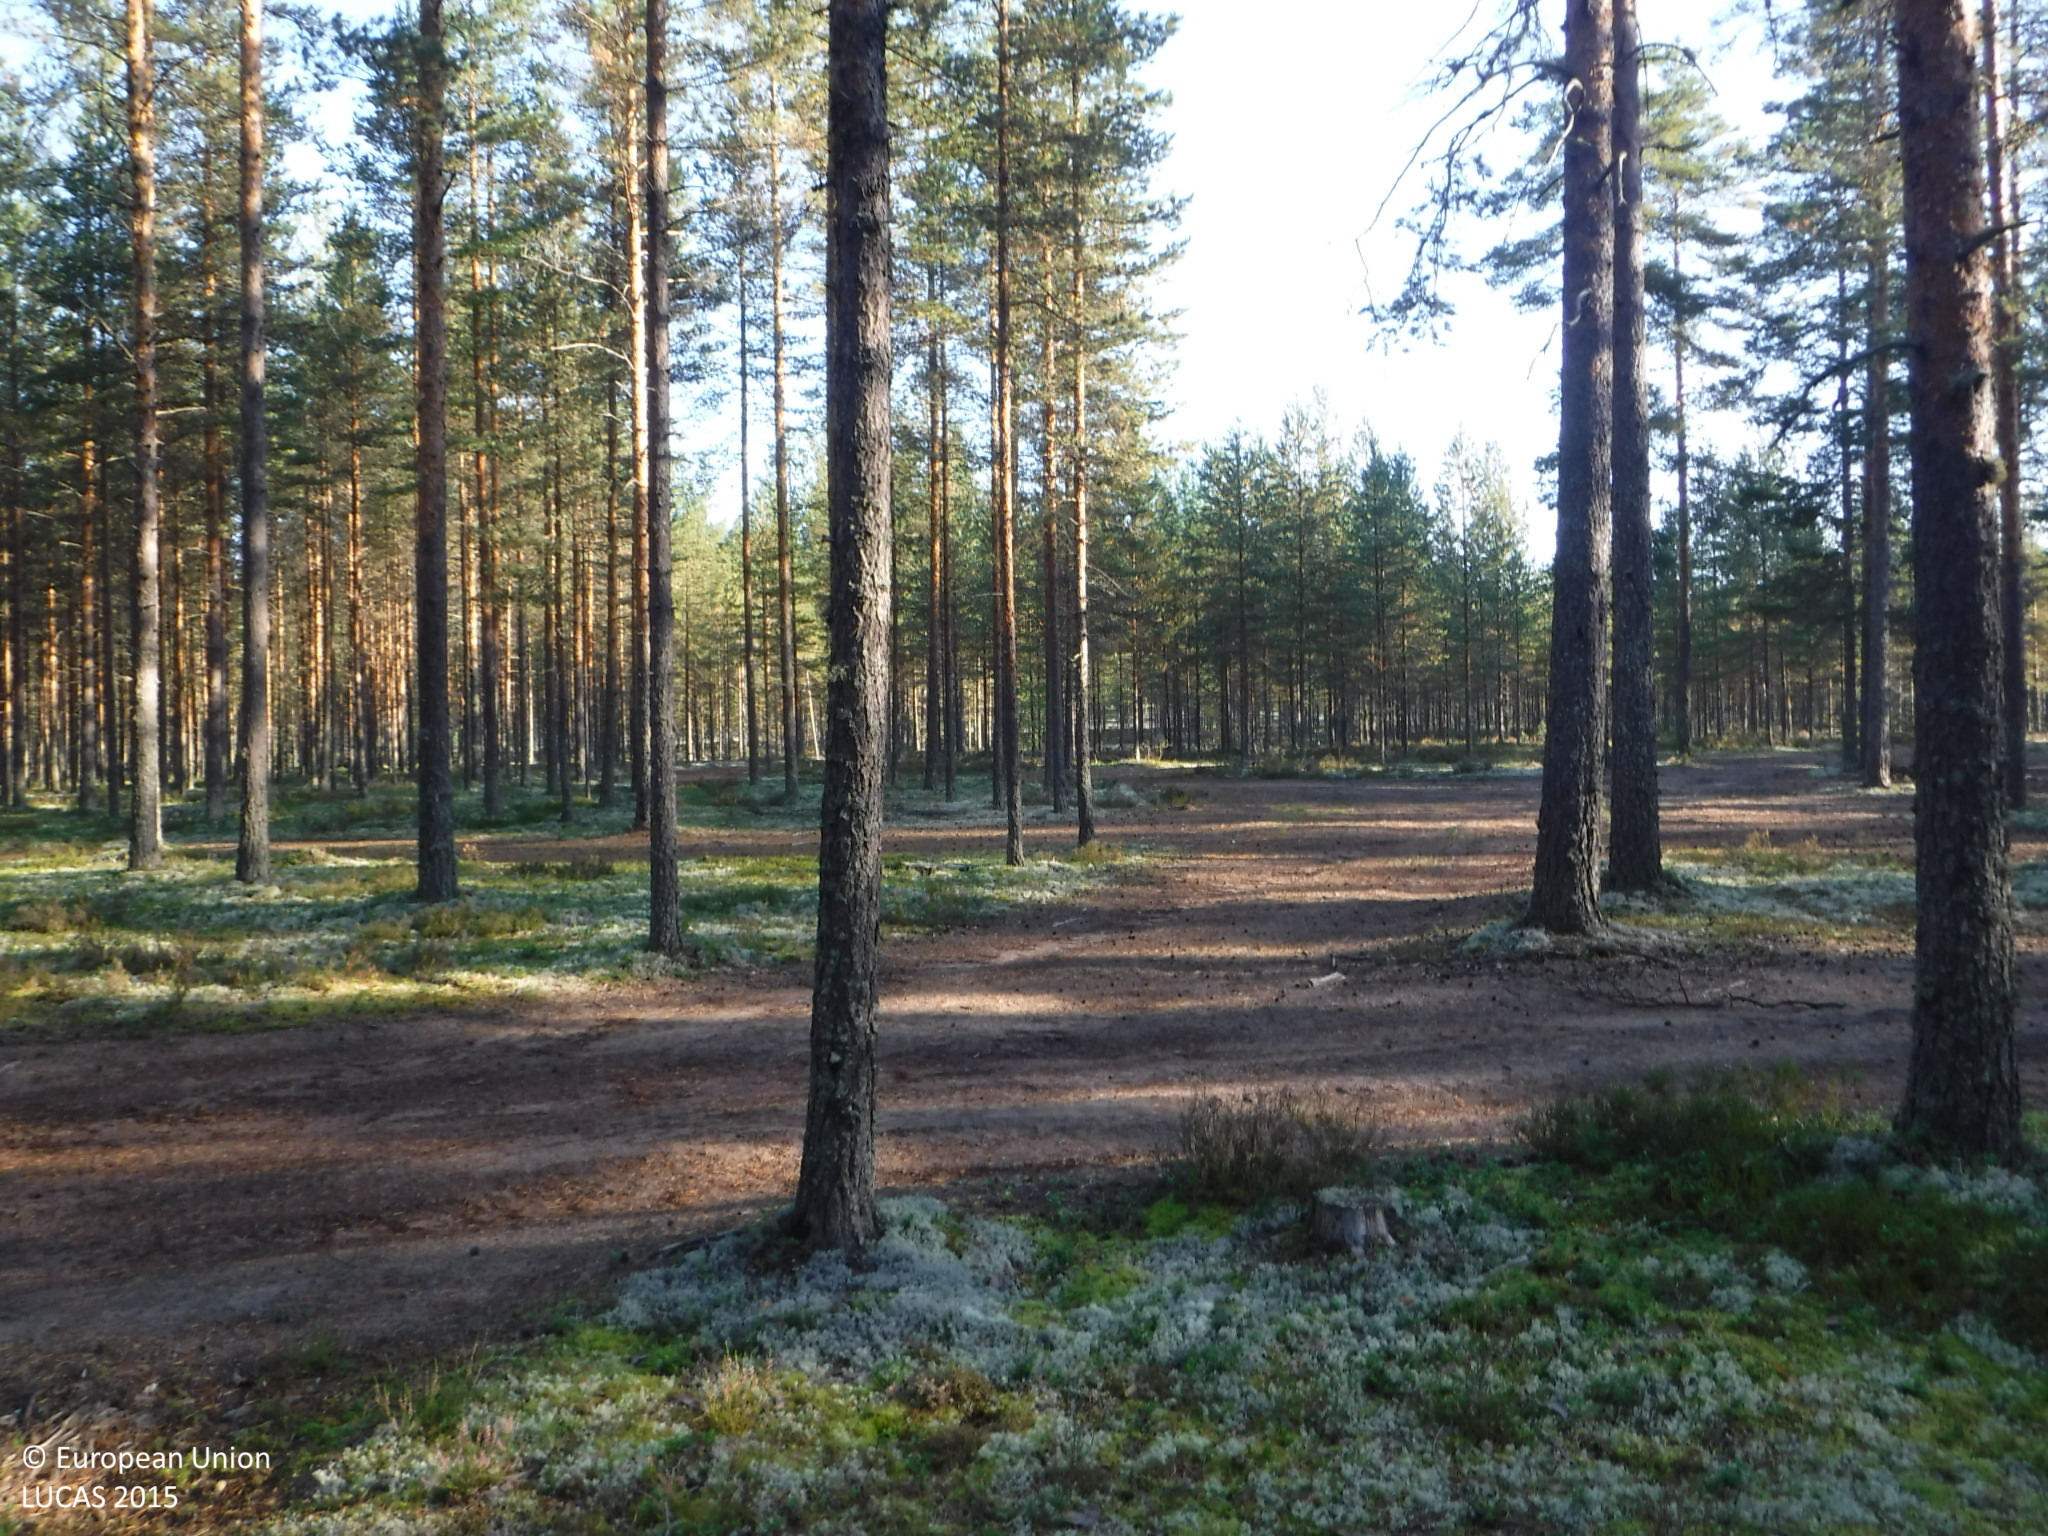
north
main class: Woodland
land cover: Pine dominated coniferous woodland
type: boreal forest
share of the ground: 25 - 50 %
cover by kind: lichens and mosses 55 %, coniferous forest trees 30 %, shrubs 15 %
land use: Community services
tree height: > 5 m
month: September
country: FI
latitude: 61.7640
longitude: 22.6639
